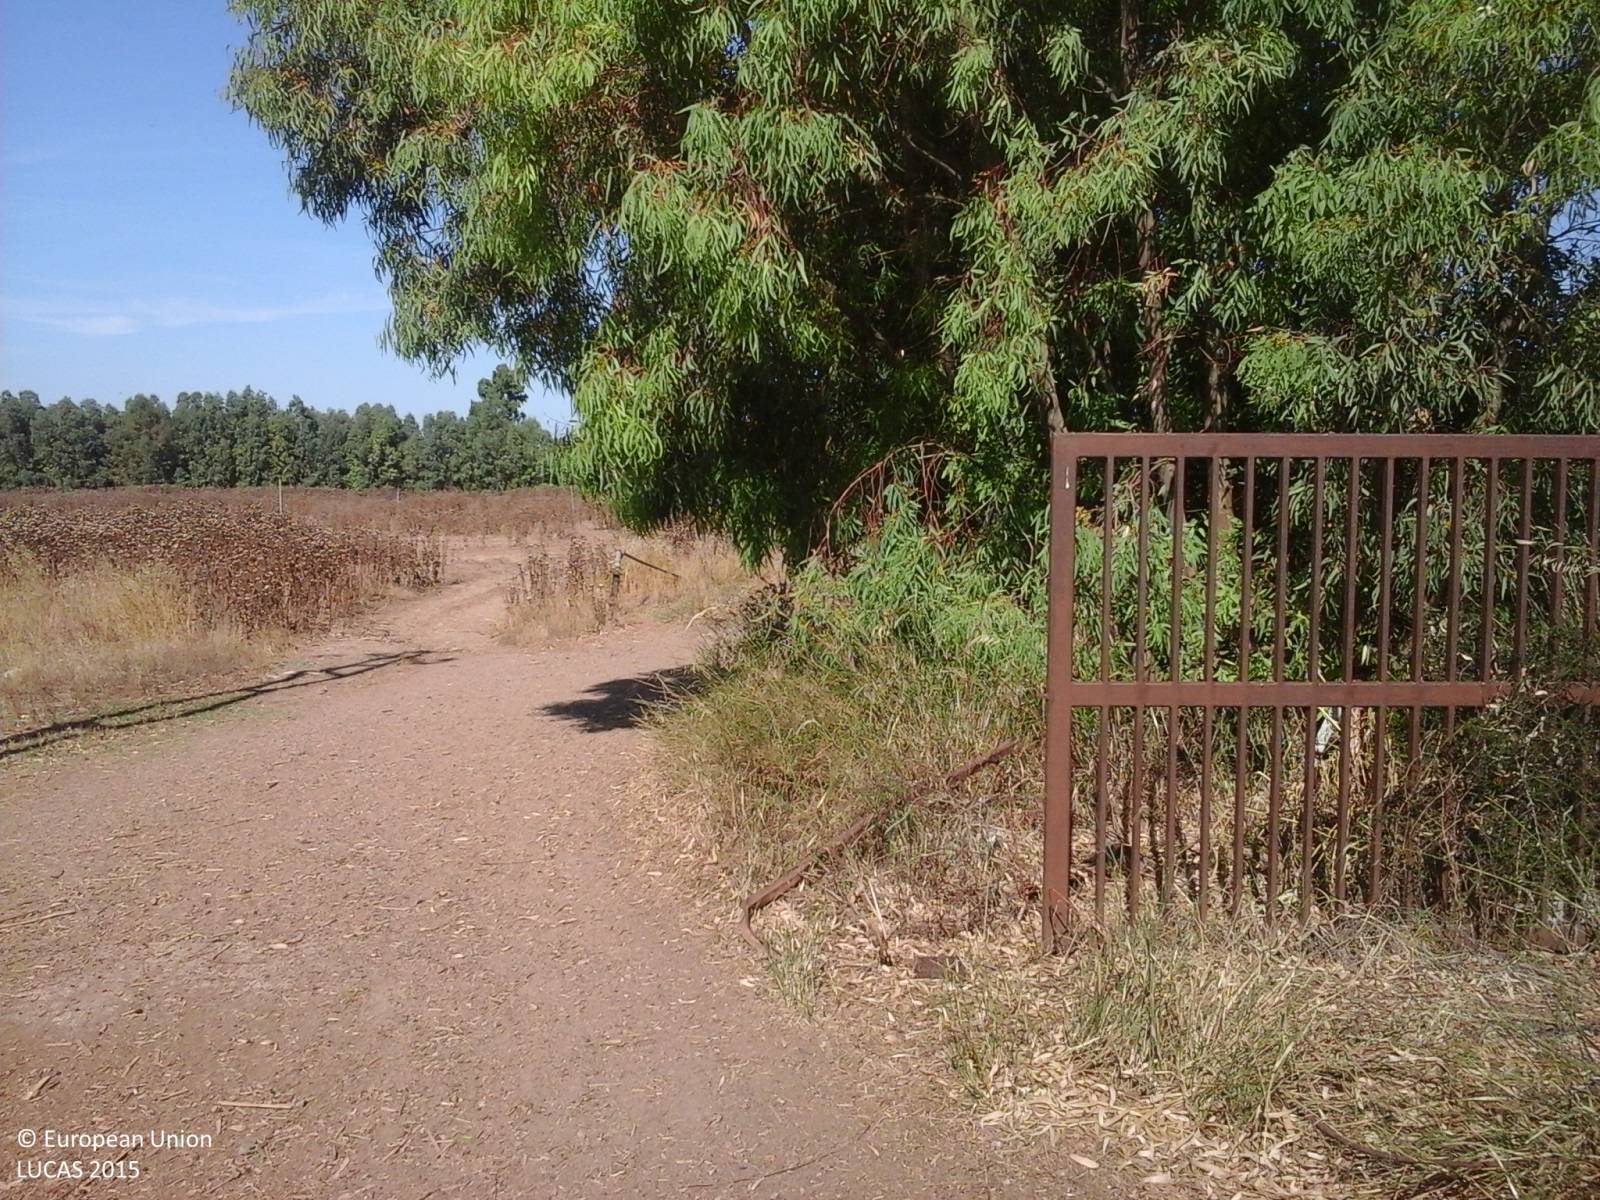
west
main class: Cropland
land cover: Temporary grasslands
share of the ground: > 75 %
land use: Agriculture (excluding fallow land and kitchen gardens)
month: June
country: IT
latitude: 39.2980
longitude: 8.6516
